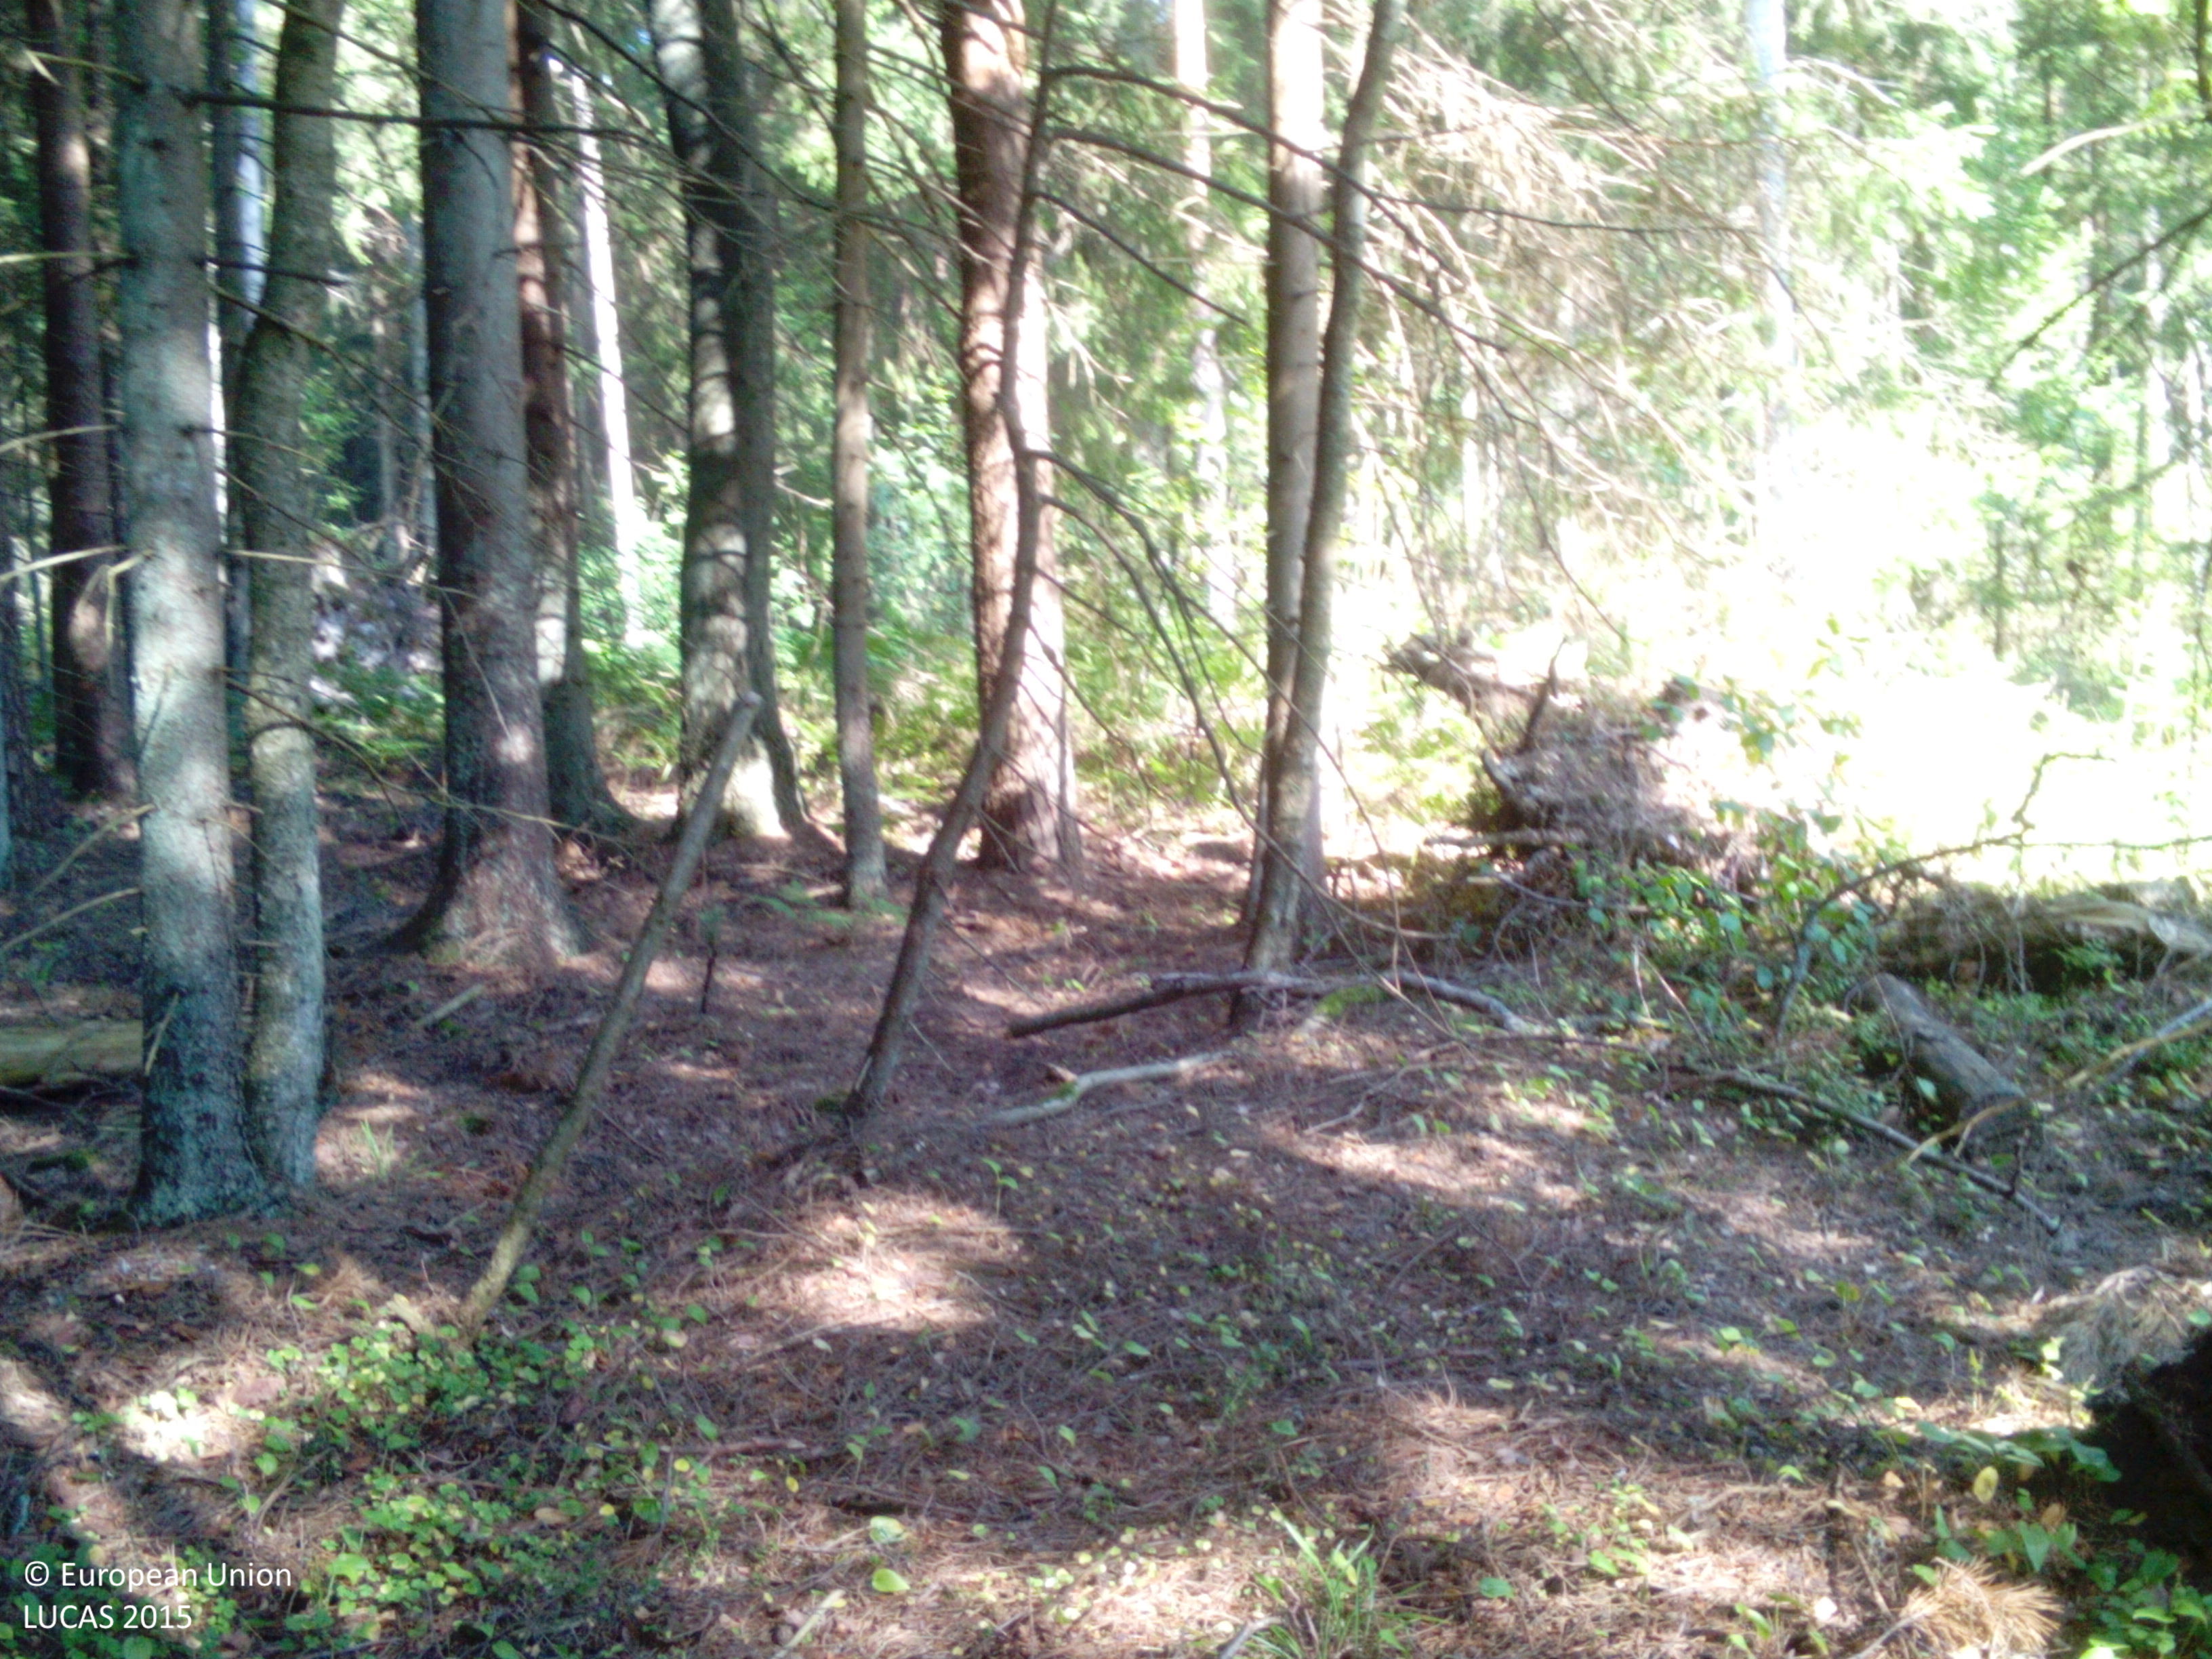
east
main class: Woodland
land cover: Other coniferous woodland
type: hemiboreal forest and nemoral coniferous forest and mixed broadleaved-coniferous forest
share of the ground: > 75 %
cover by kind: coniferous forest trees 85 %, herbaceous plants 10 %, unconsolidated bare surface 5 %
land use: Forestry
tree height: > 5 m
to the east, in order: Other coniferous woodland; Electric lines; Other coniferous woodland; Abandoned hedges; Ditches and canals; Grass margins; Paved roads, cycling and walking lanes; Grass margins; Ditches and canals; Abandoned hedges; Other coniferous woodland; Pine dominated coniferous woodland; Other coniferous woodland; Ditches and canals; Other coniferous woodland
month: August
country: LV
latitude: 56.3659
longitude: 21.2251
